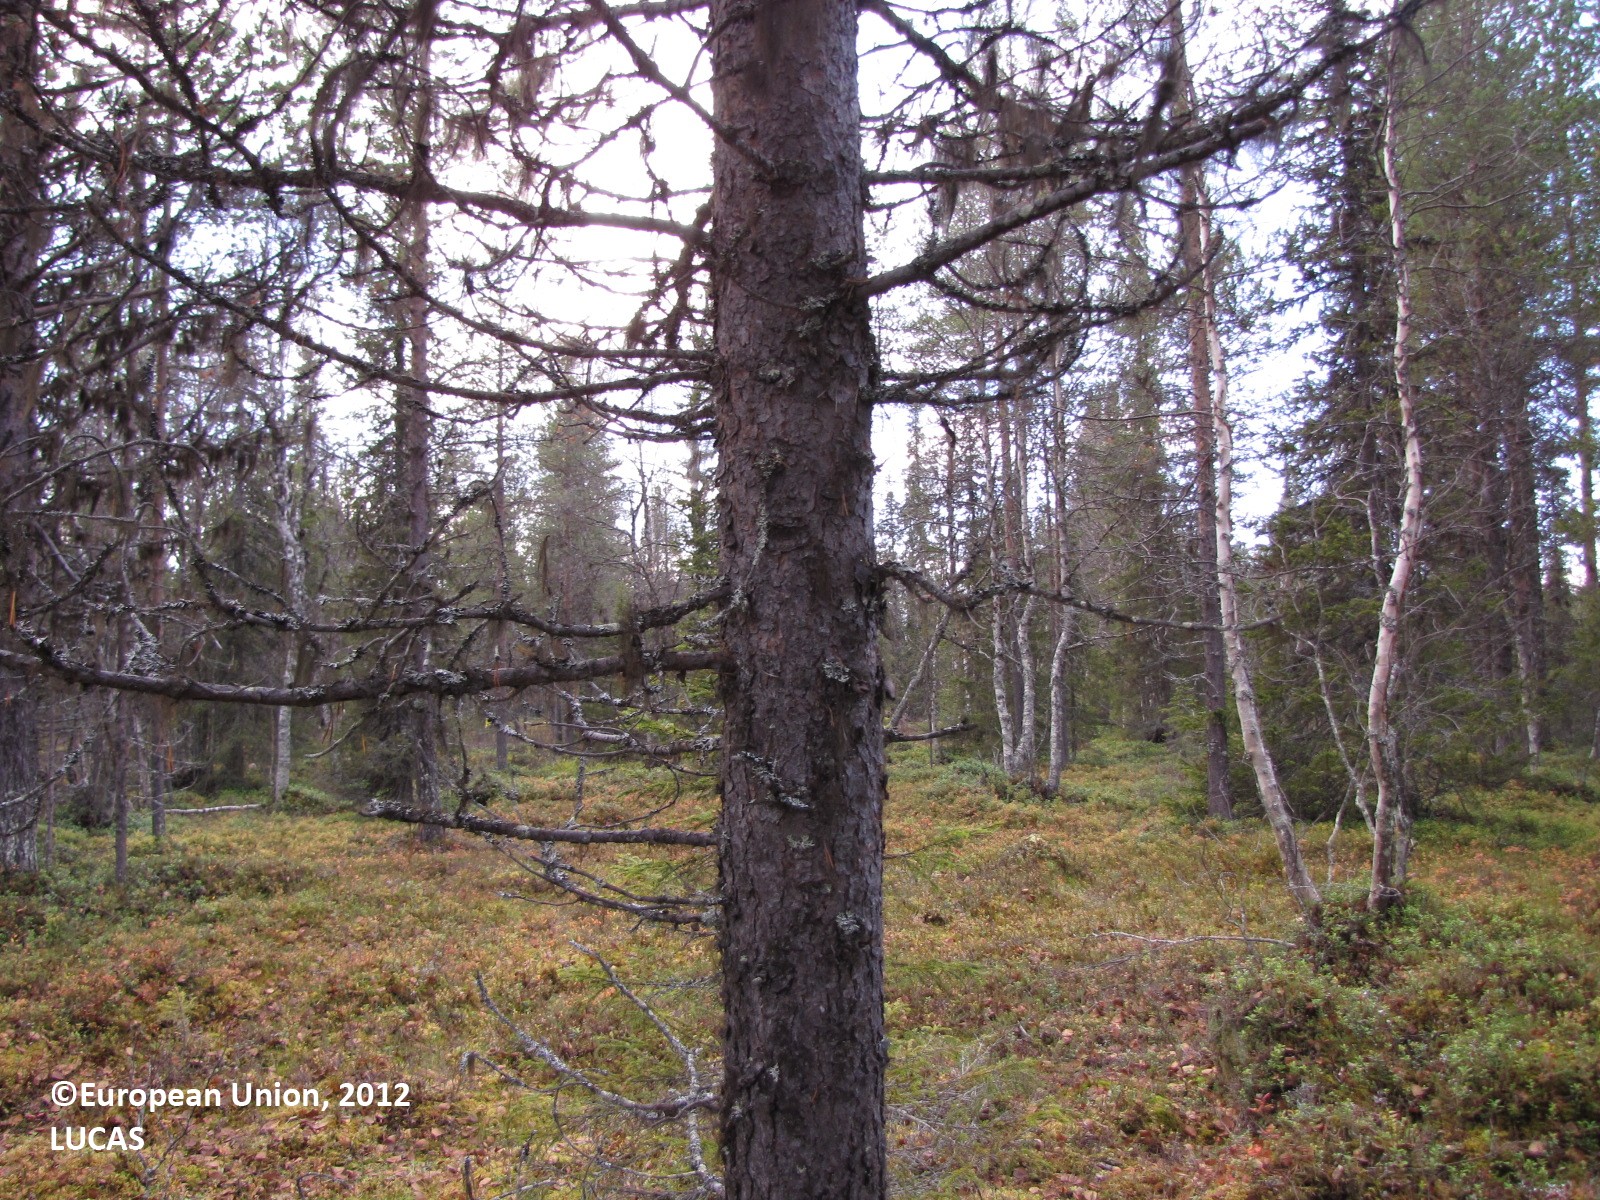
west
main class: Woodland
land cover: Pine dominated mixed woodland
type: boreal forest
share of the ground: 25 - 50 %
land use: Forestry
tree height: > 5 m
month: September
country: FI
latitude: 67.9046
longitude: 24.2430
